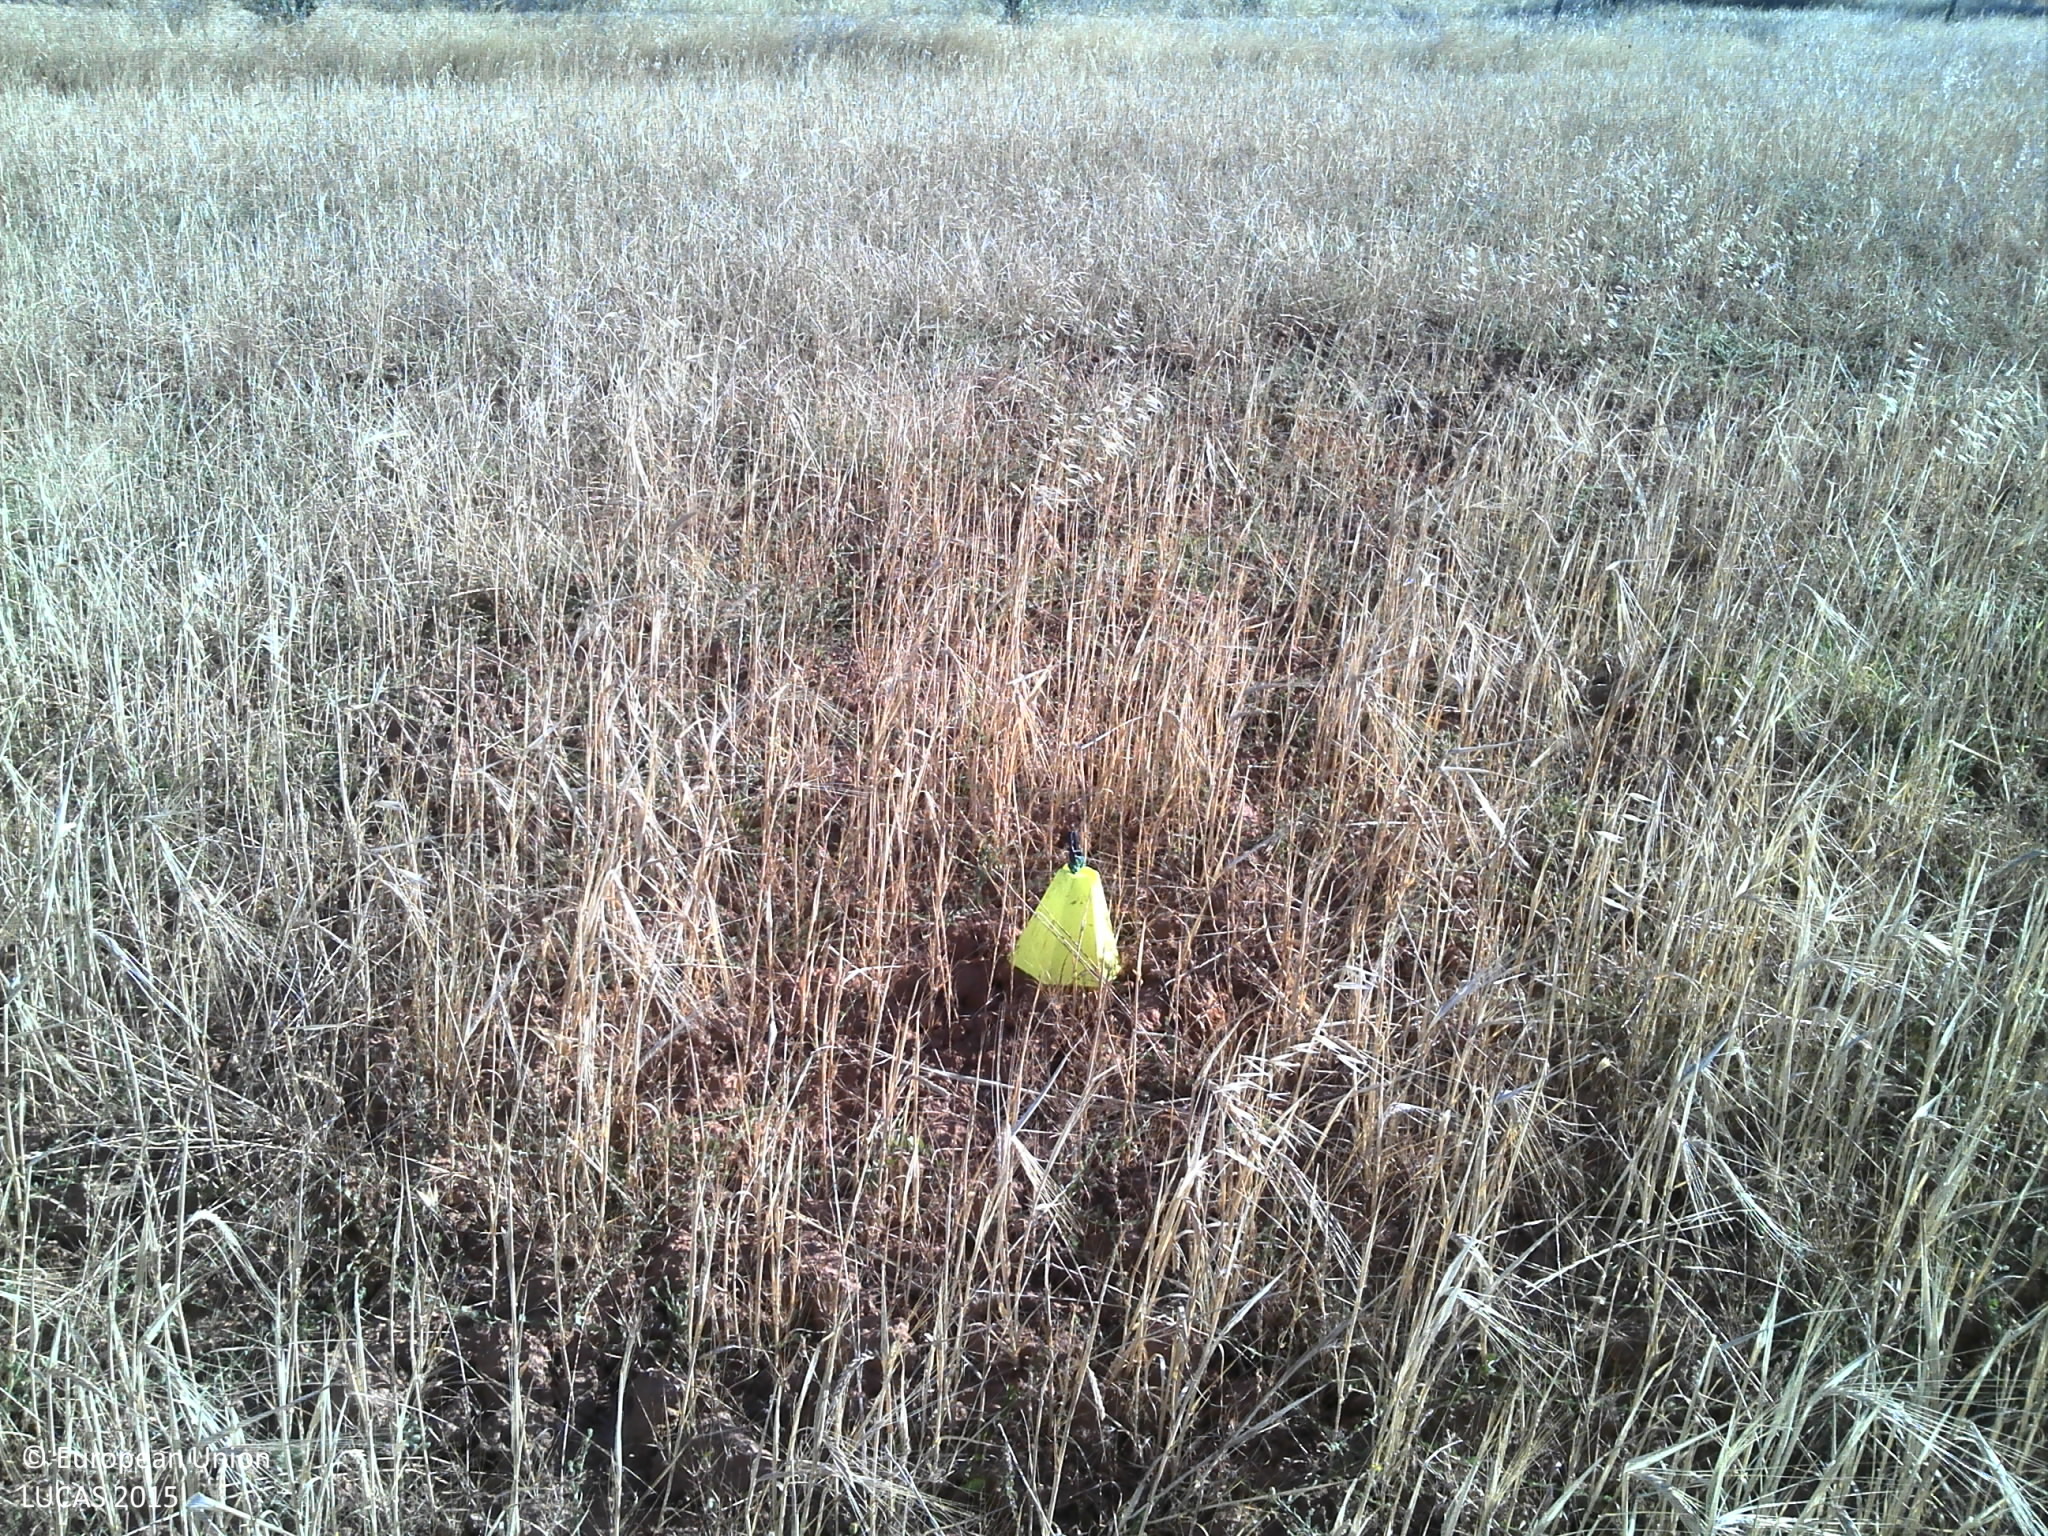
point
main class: Cropland
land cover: Triticale
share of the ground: 10 - 25 %
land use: Agriculture (excluding fallow land and kitchen gardens)
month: July
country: PT
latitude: 38.9281
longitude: -7.5596
